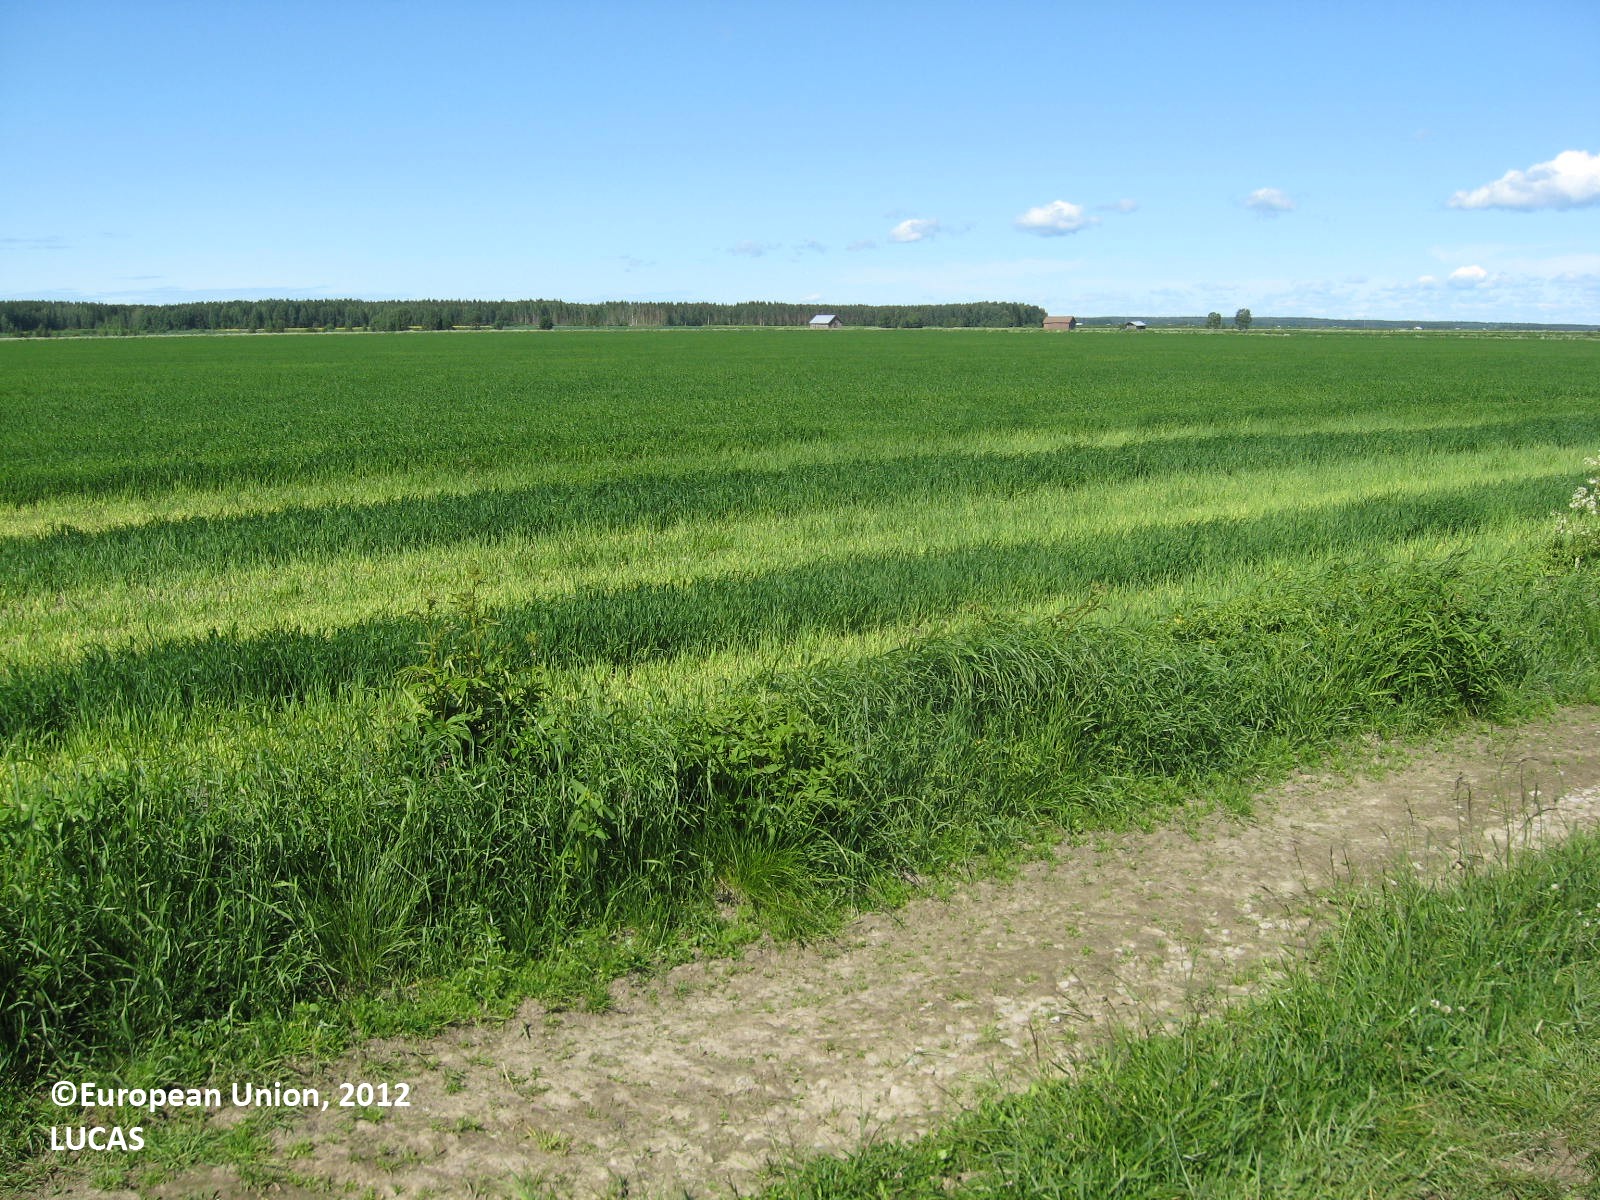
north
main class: Cropland
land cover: Oats
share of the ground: 50 - 75 %
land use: Agriculture (excluding fallow land and kitchen gardens)
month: June
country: FI
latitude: 62.7750
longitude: 22.6142
